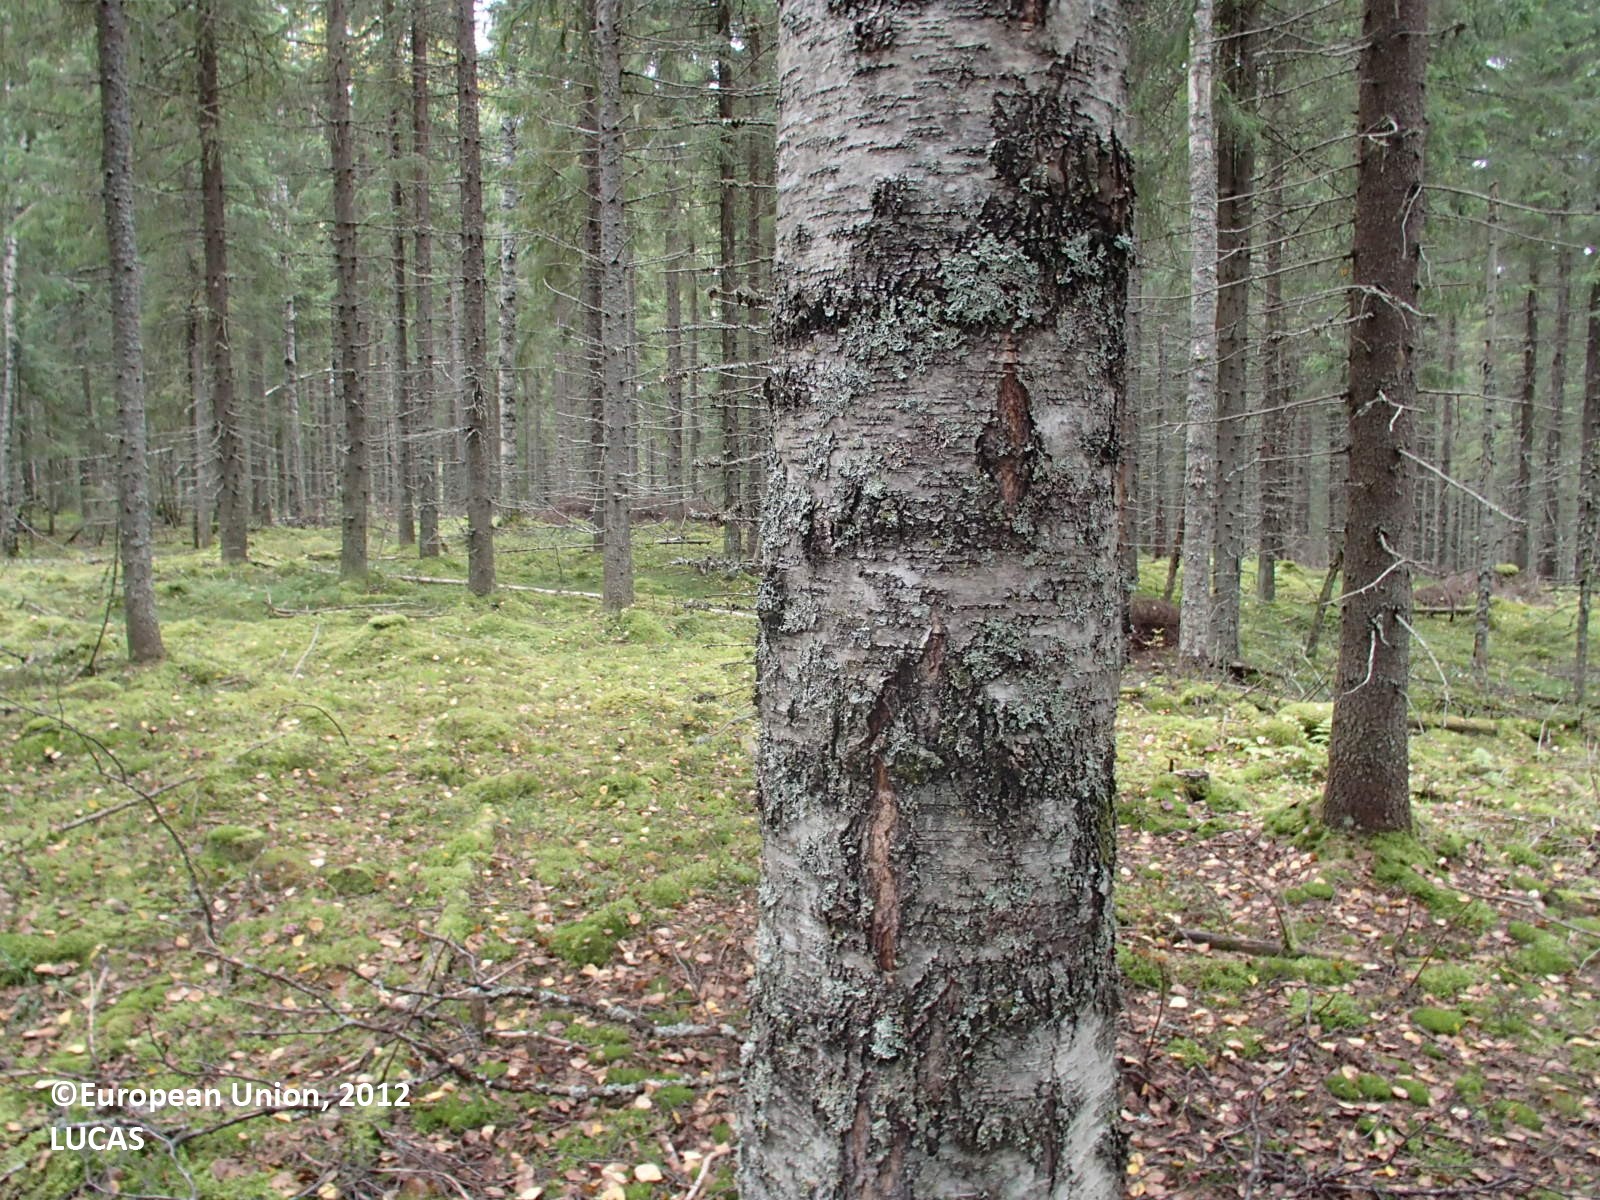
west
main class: Woodland
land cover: Spruce dominated mixed woodland
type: boreal forest
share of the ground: > 75 %
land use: Forestry
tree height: > 5 m
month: September
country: FI
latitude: 63.8292
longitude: 27.2764
